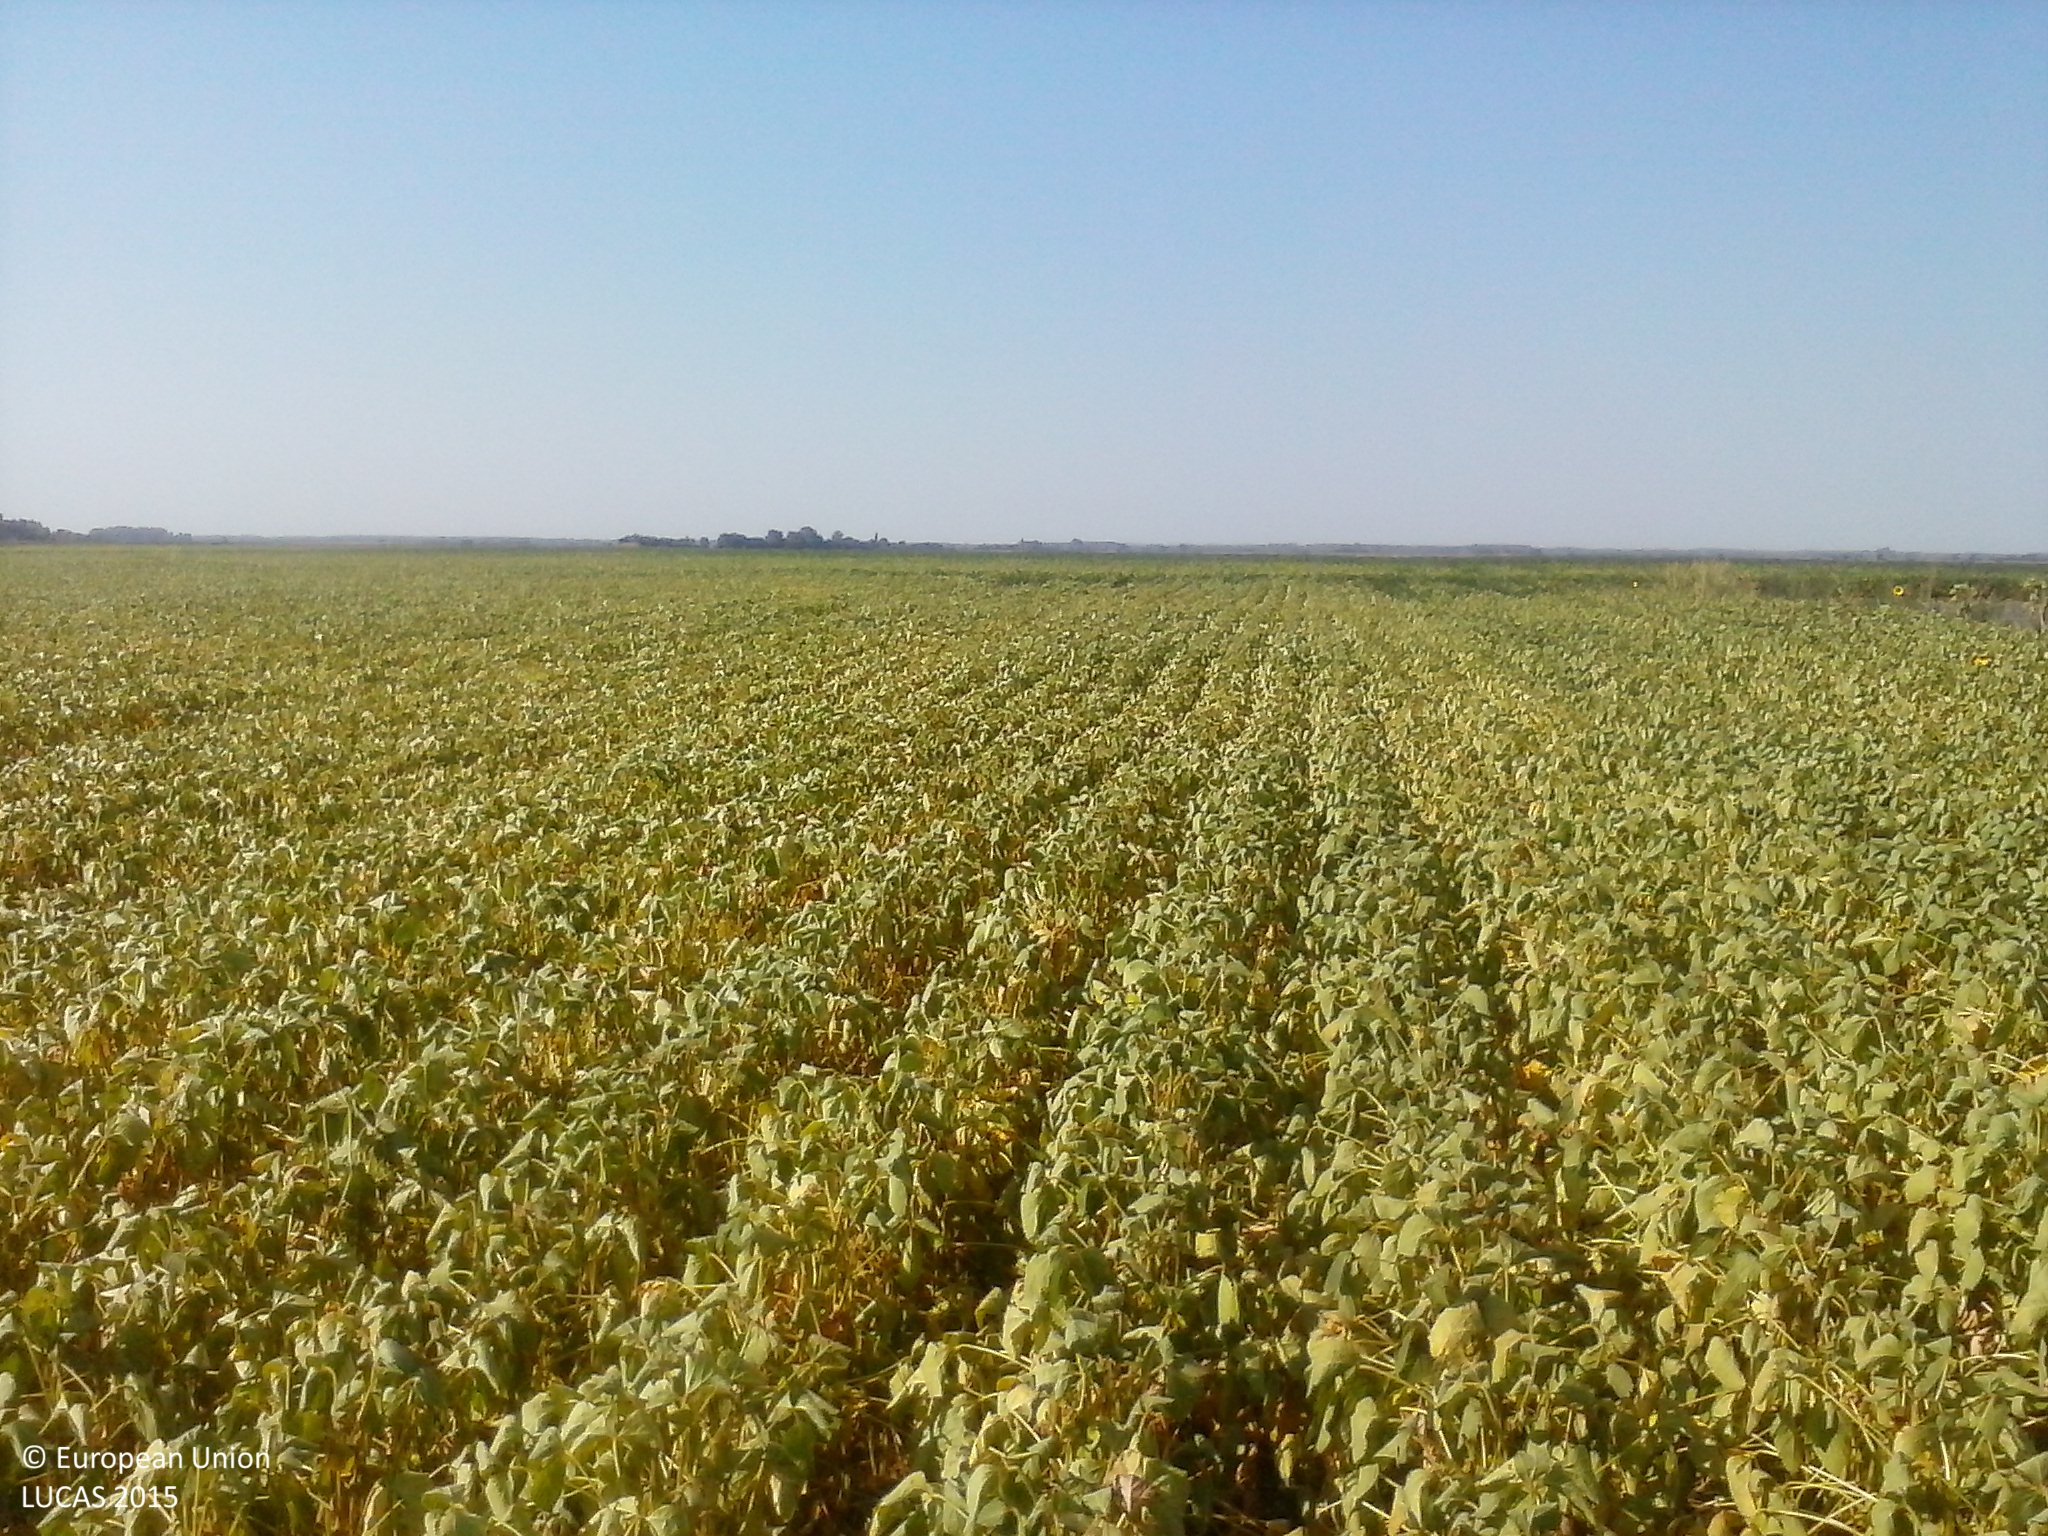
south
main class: Cropland
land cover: Soya
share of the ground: > 75 %
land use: Agriculture (excluding fallow land and kitchen gardens)
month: July
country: HU
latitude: 46.0193
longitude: 18.8588
